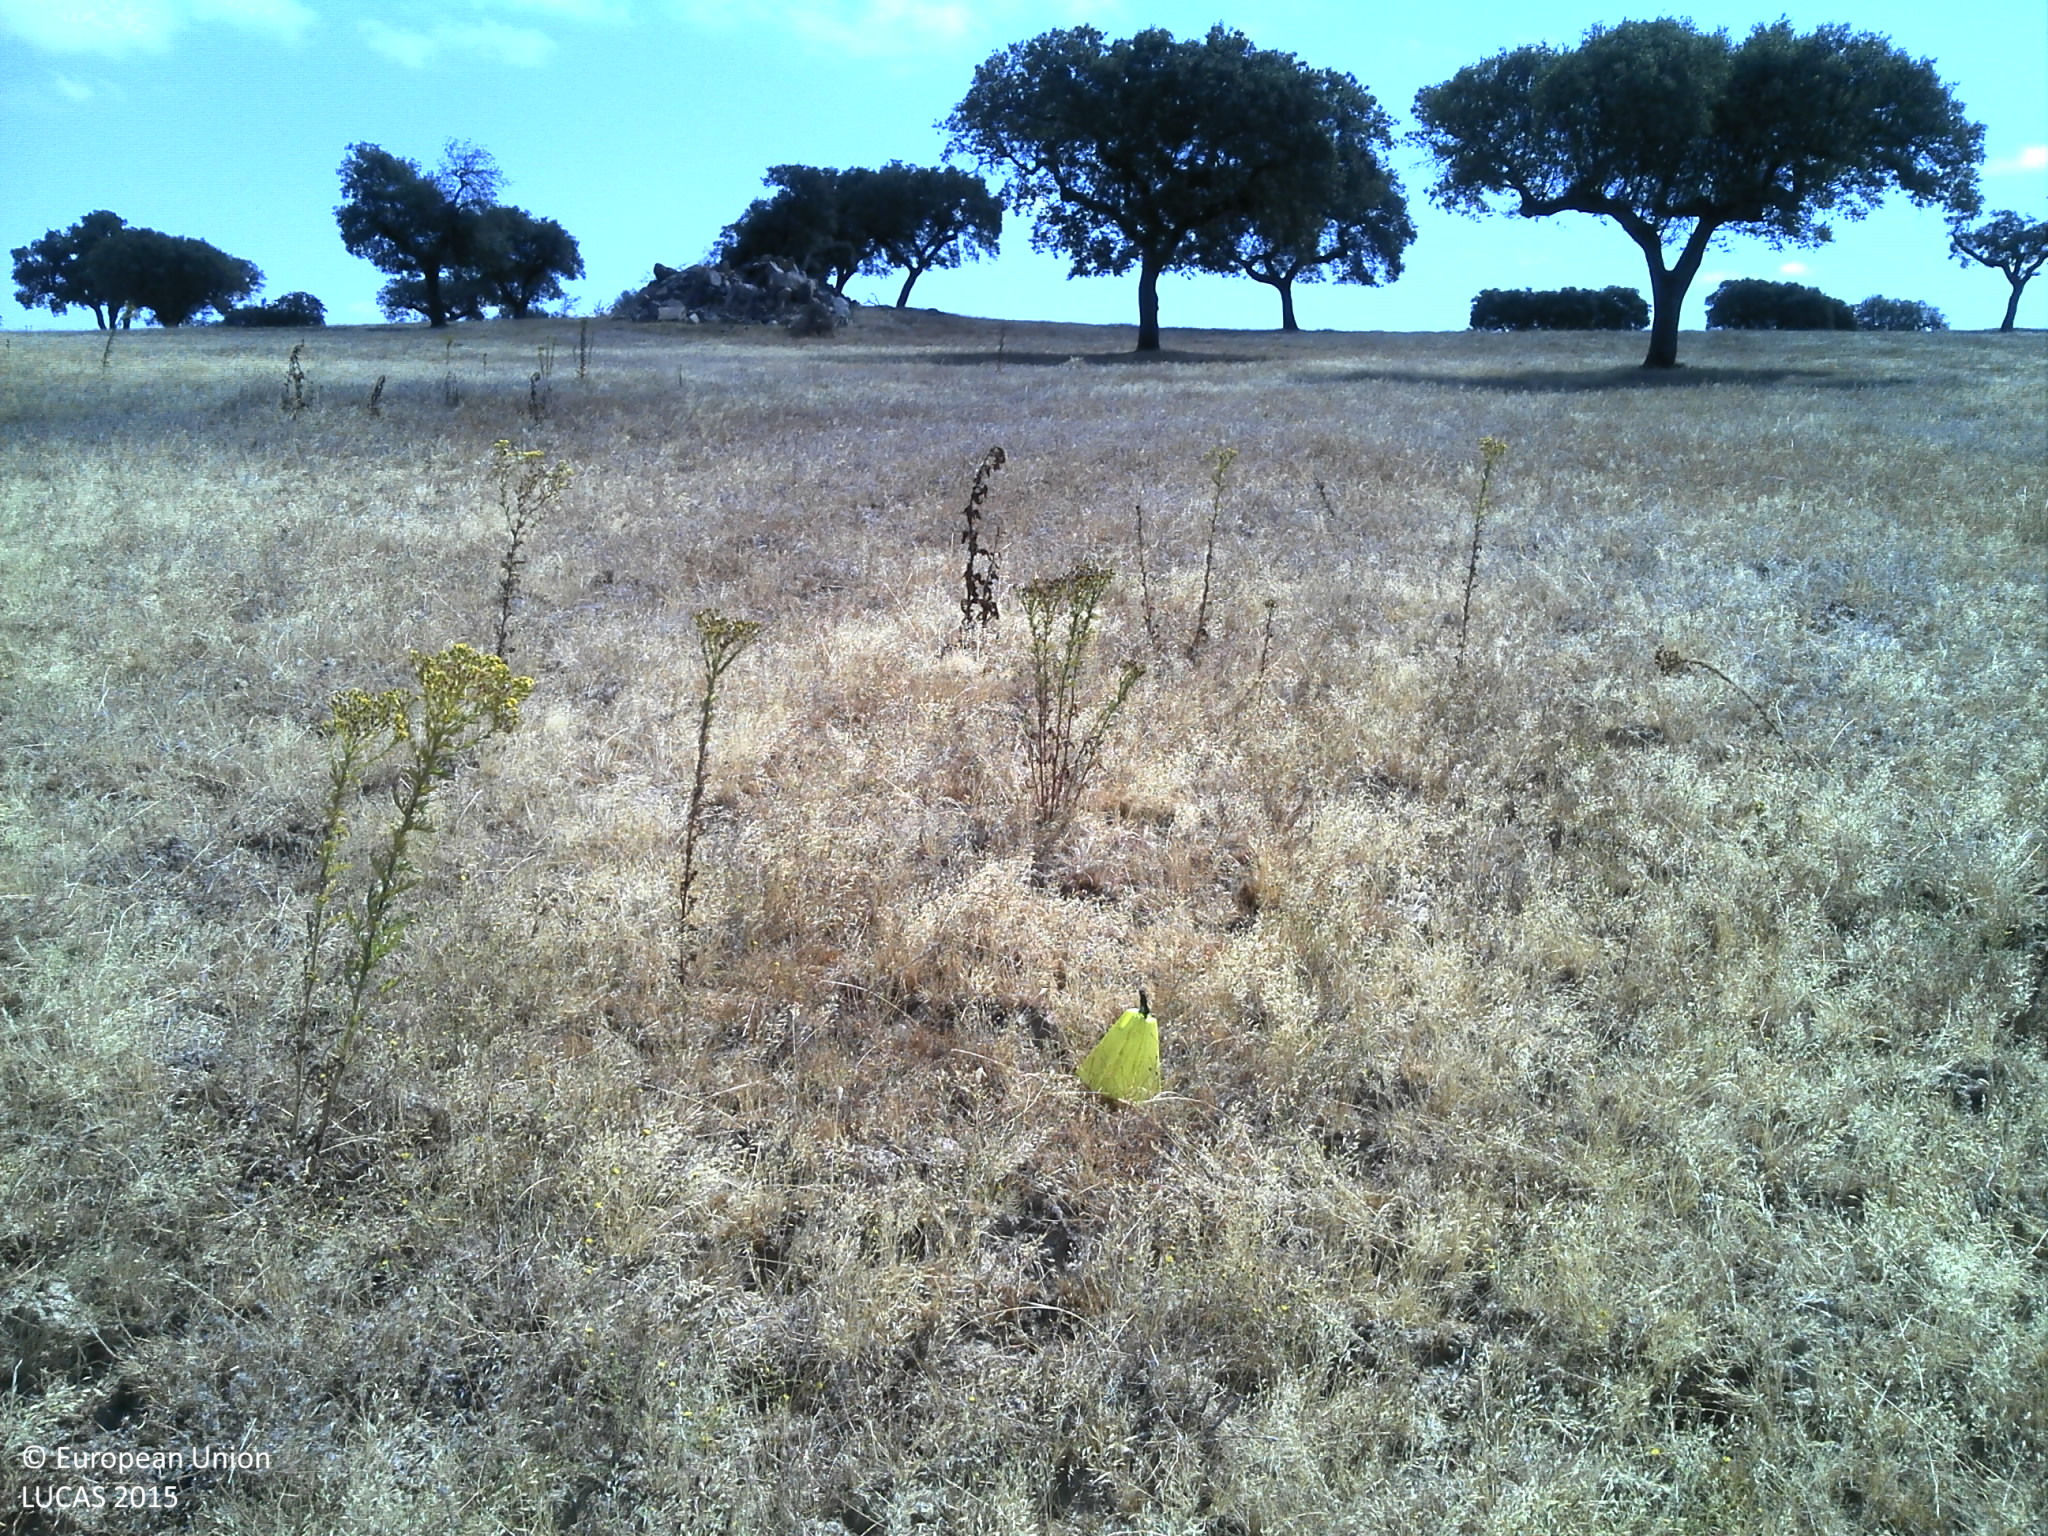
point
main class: Grassland
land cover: Spontaneously vegetated surfaces
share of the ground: 25 - 50 %
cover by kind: unconsolidated bare surface 70 %, herbaceous plants 30 %
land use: Agriculture (excluding fallow land and kitchen gardens)
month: July
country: PT
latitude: 39.2063
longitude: -7.3507
